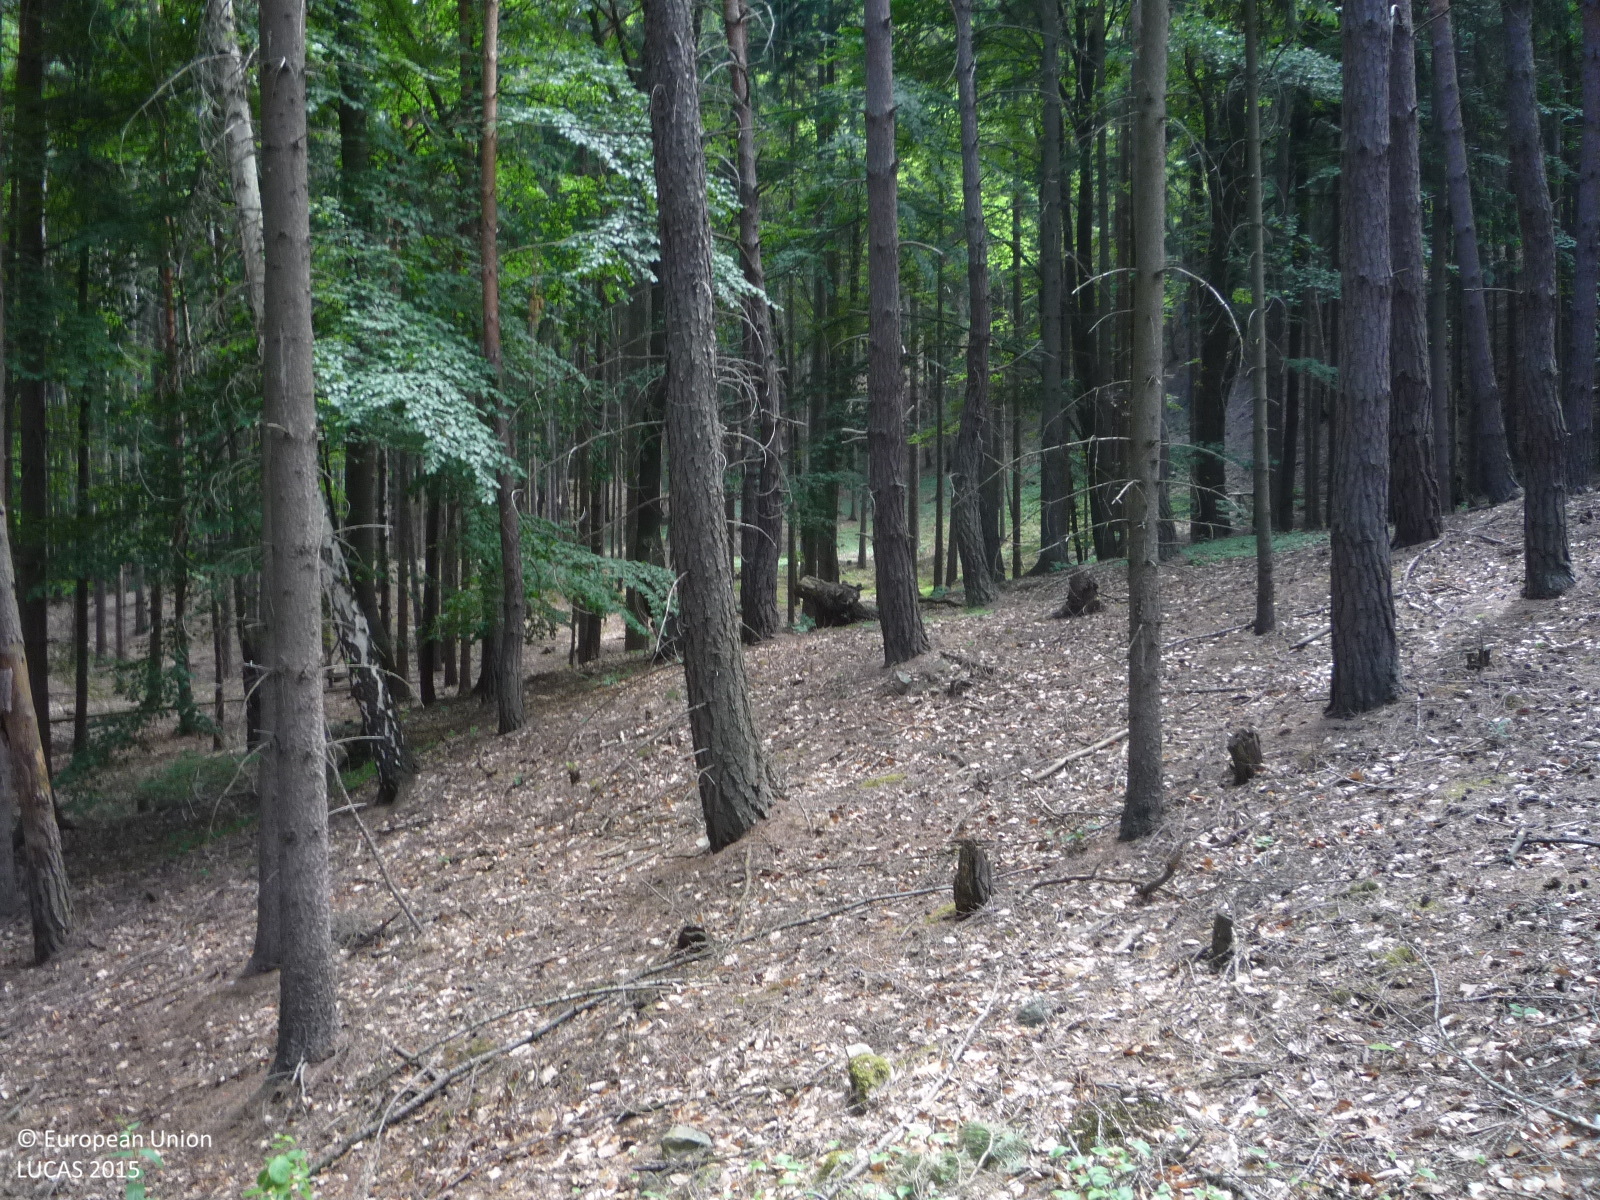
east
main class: Woodland
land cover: Other mixed woodland
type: hemiboreal forest and nemoral coniferous forest and mixed broadleaved-coniferous forest
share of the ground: > 75 %
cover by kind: coniferous forest trees 60 %, broadleaved forest trees 30 %, herbaceous plants 5 %, unconsolidated bare surface 5 %
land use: Forestry
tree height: > 5 m
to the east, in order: Other mixed woodland; Spruce dominated coniferous woodland; Other mixed woodland; Tracks; Spruce dominated coniferous woodland; Other mixed woodland
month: June
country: CZ
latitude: 50.2092
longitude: 13.8541
